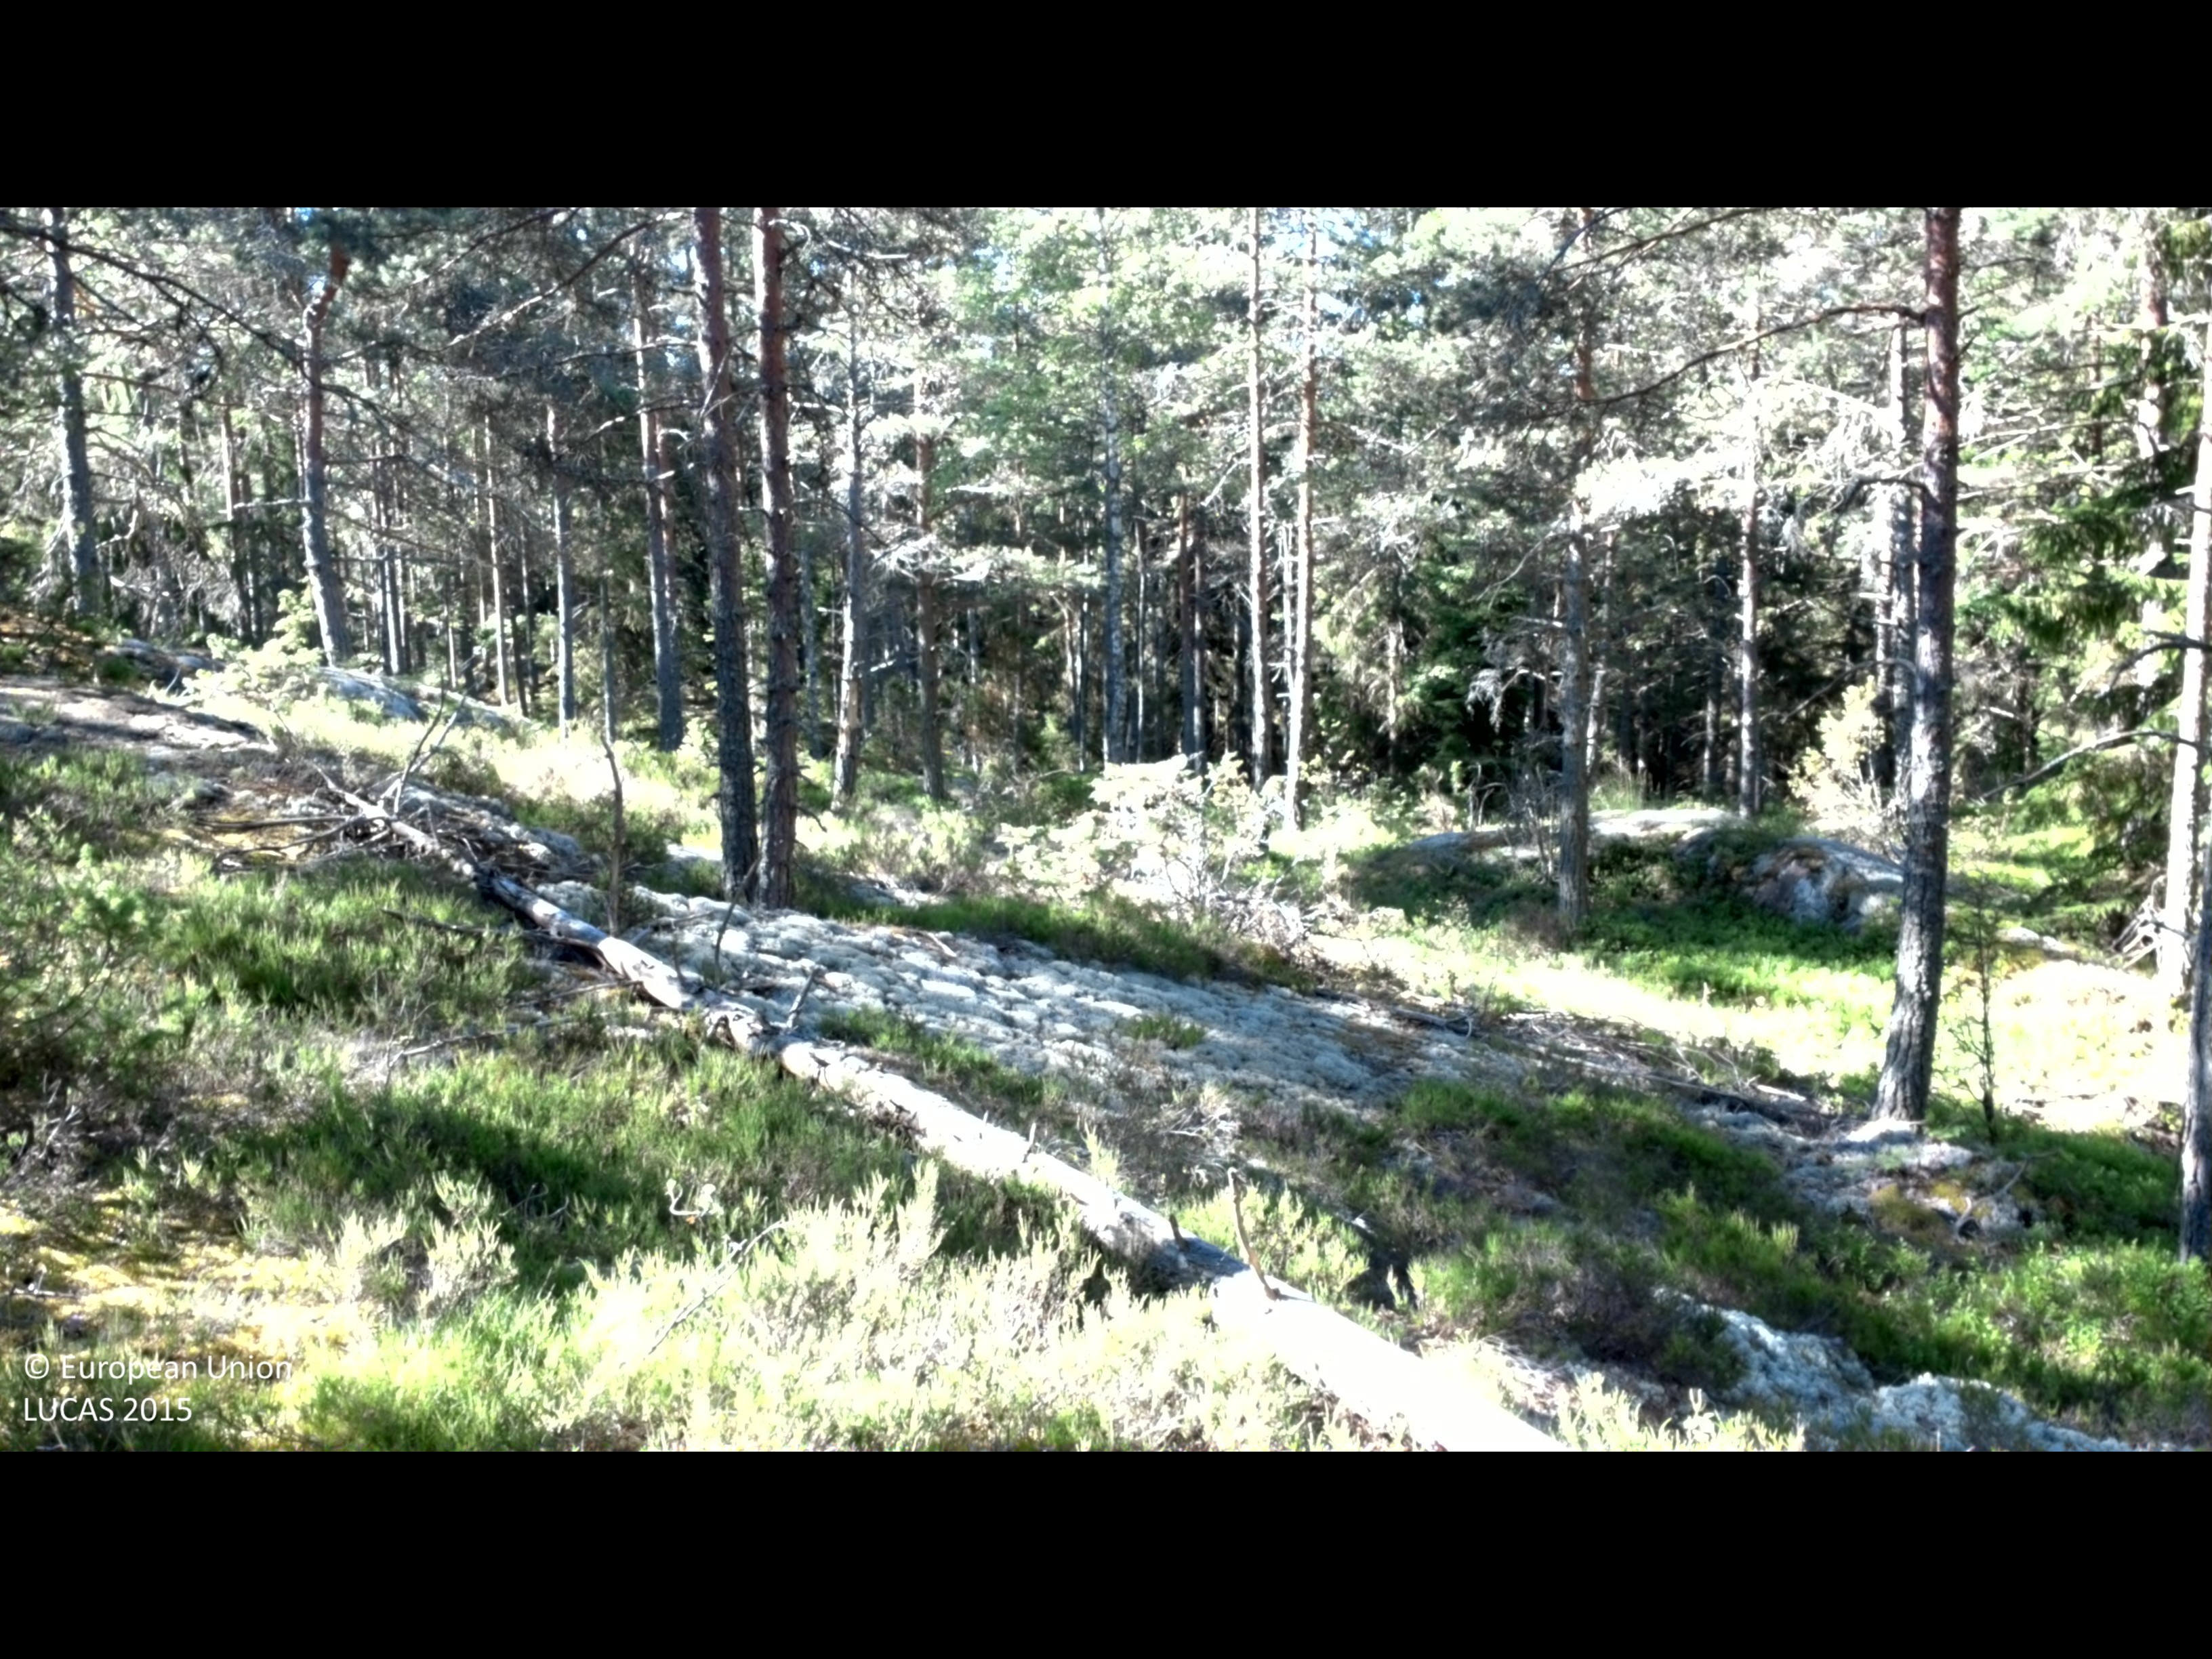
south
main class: Woodland
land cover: Pine dominated coniferous woodland
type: boreal forest
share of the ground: 50 - 75 %
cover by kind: coniferous forest trees 55 %, shrubs 25 %, lichens and mosses 15 %, broadleaved forest trees 5 %
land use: Forestry
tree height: > 5 m
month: July
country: SE
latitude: 58.1977
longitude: 16.6838
